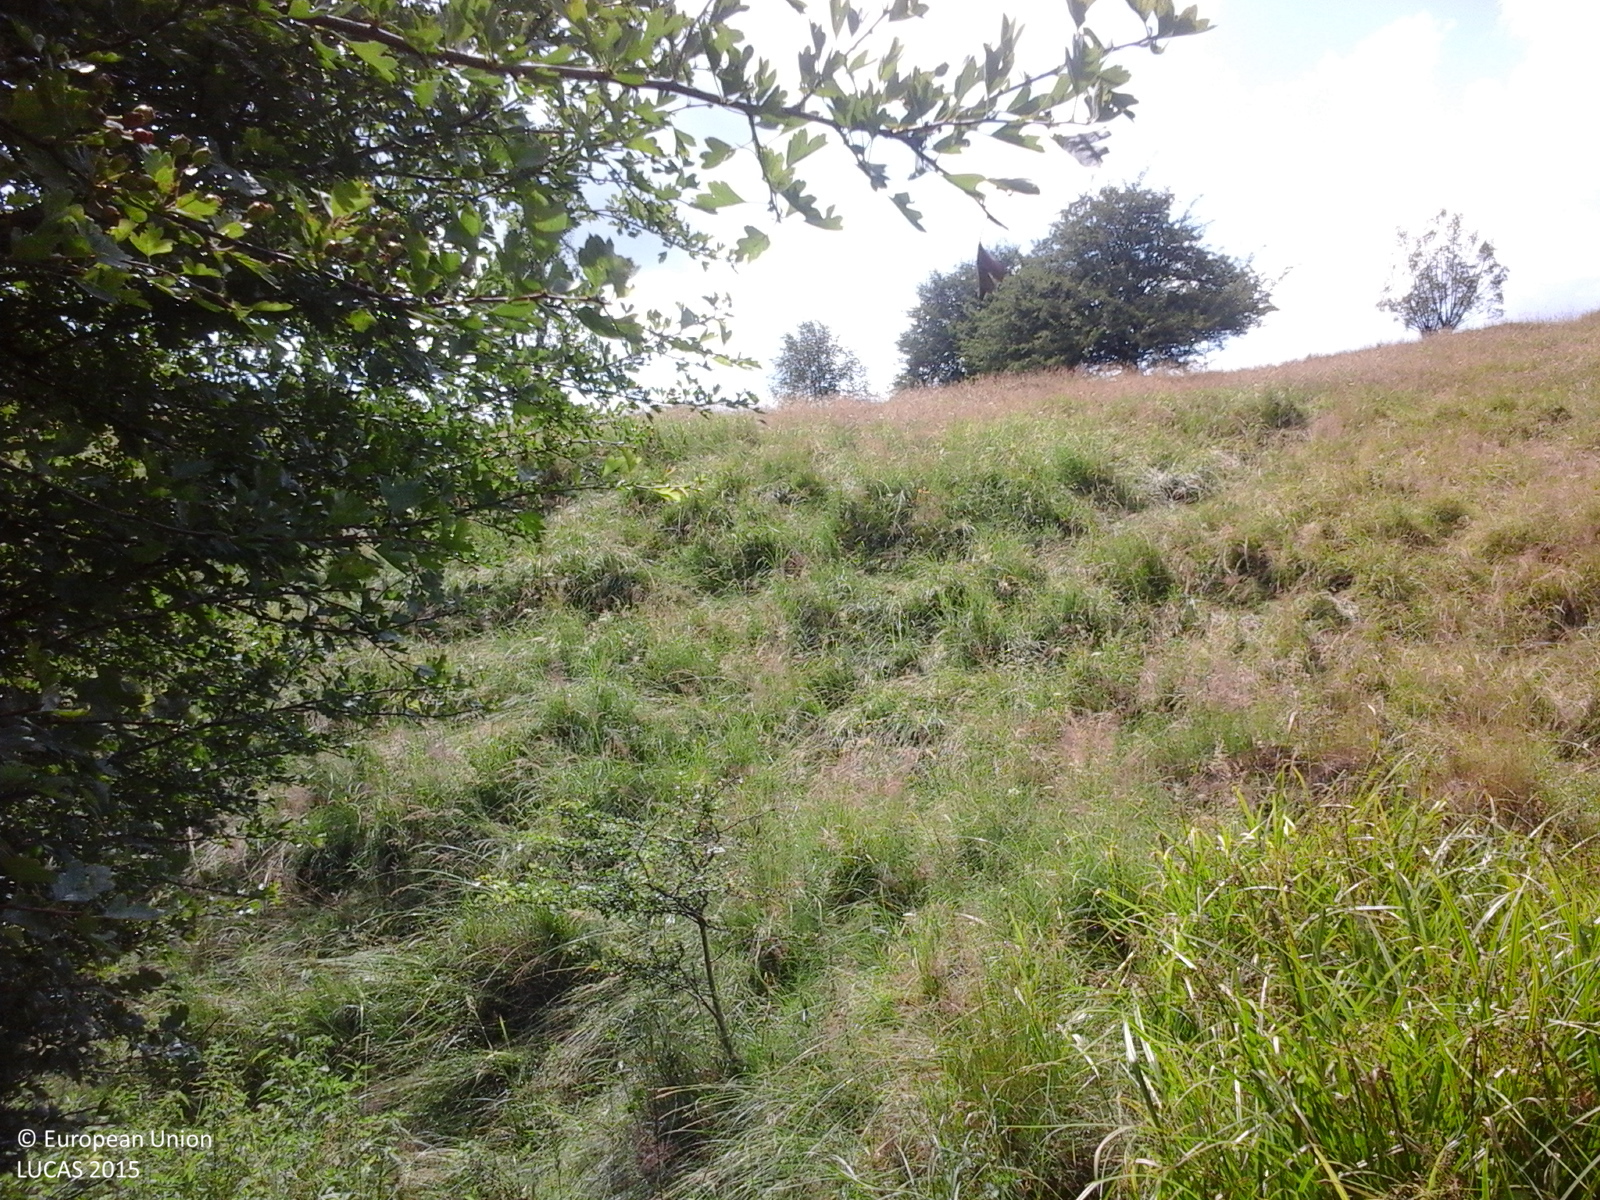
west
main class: Grassland
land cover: Grassland with sparse tree/shrub cover
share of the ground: > 75 %
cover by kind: herbaceous plants 95 %, broadleaved forest trees 5 %
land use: Agriculture (excluding fallow land and kitchen gardens)
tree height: > 5 m
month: July
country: RO
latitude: 45.3722
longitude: 24.7810
